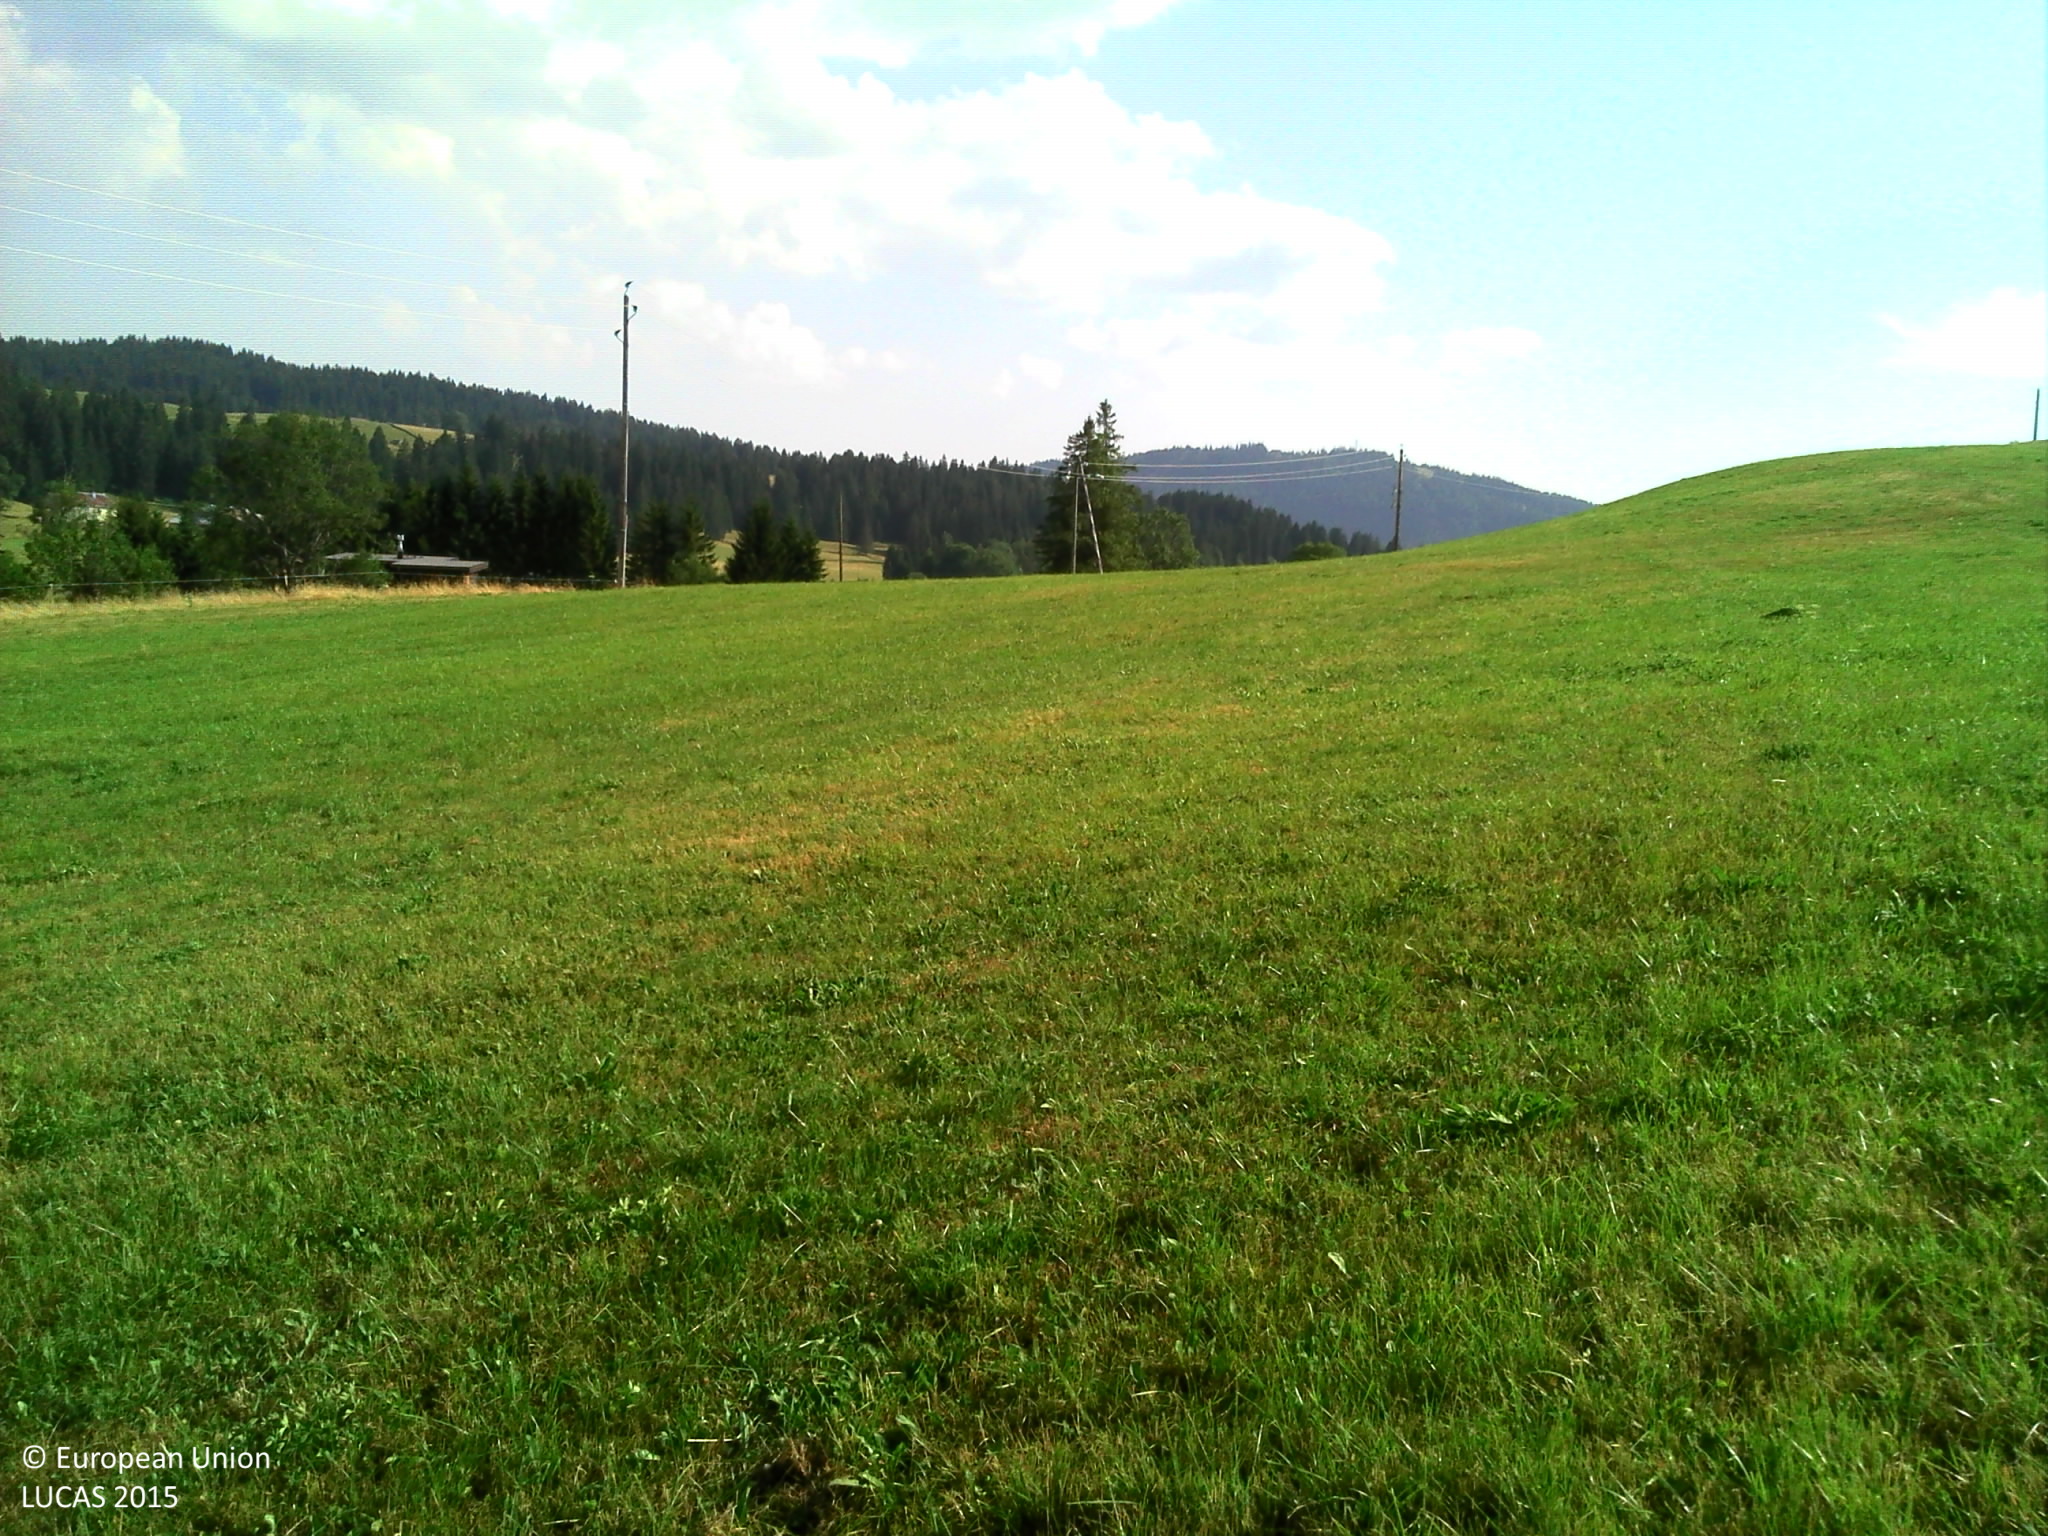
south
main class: Grassland
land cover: Grassland without tree/shrub cover
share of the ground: > 75 %
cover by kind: herbaceous plants 100 %
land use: Agriculture (excluding fallow land and kitchen gardens)
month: July
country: FR
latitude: 46.4778
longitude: 6.0825
